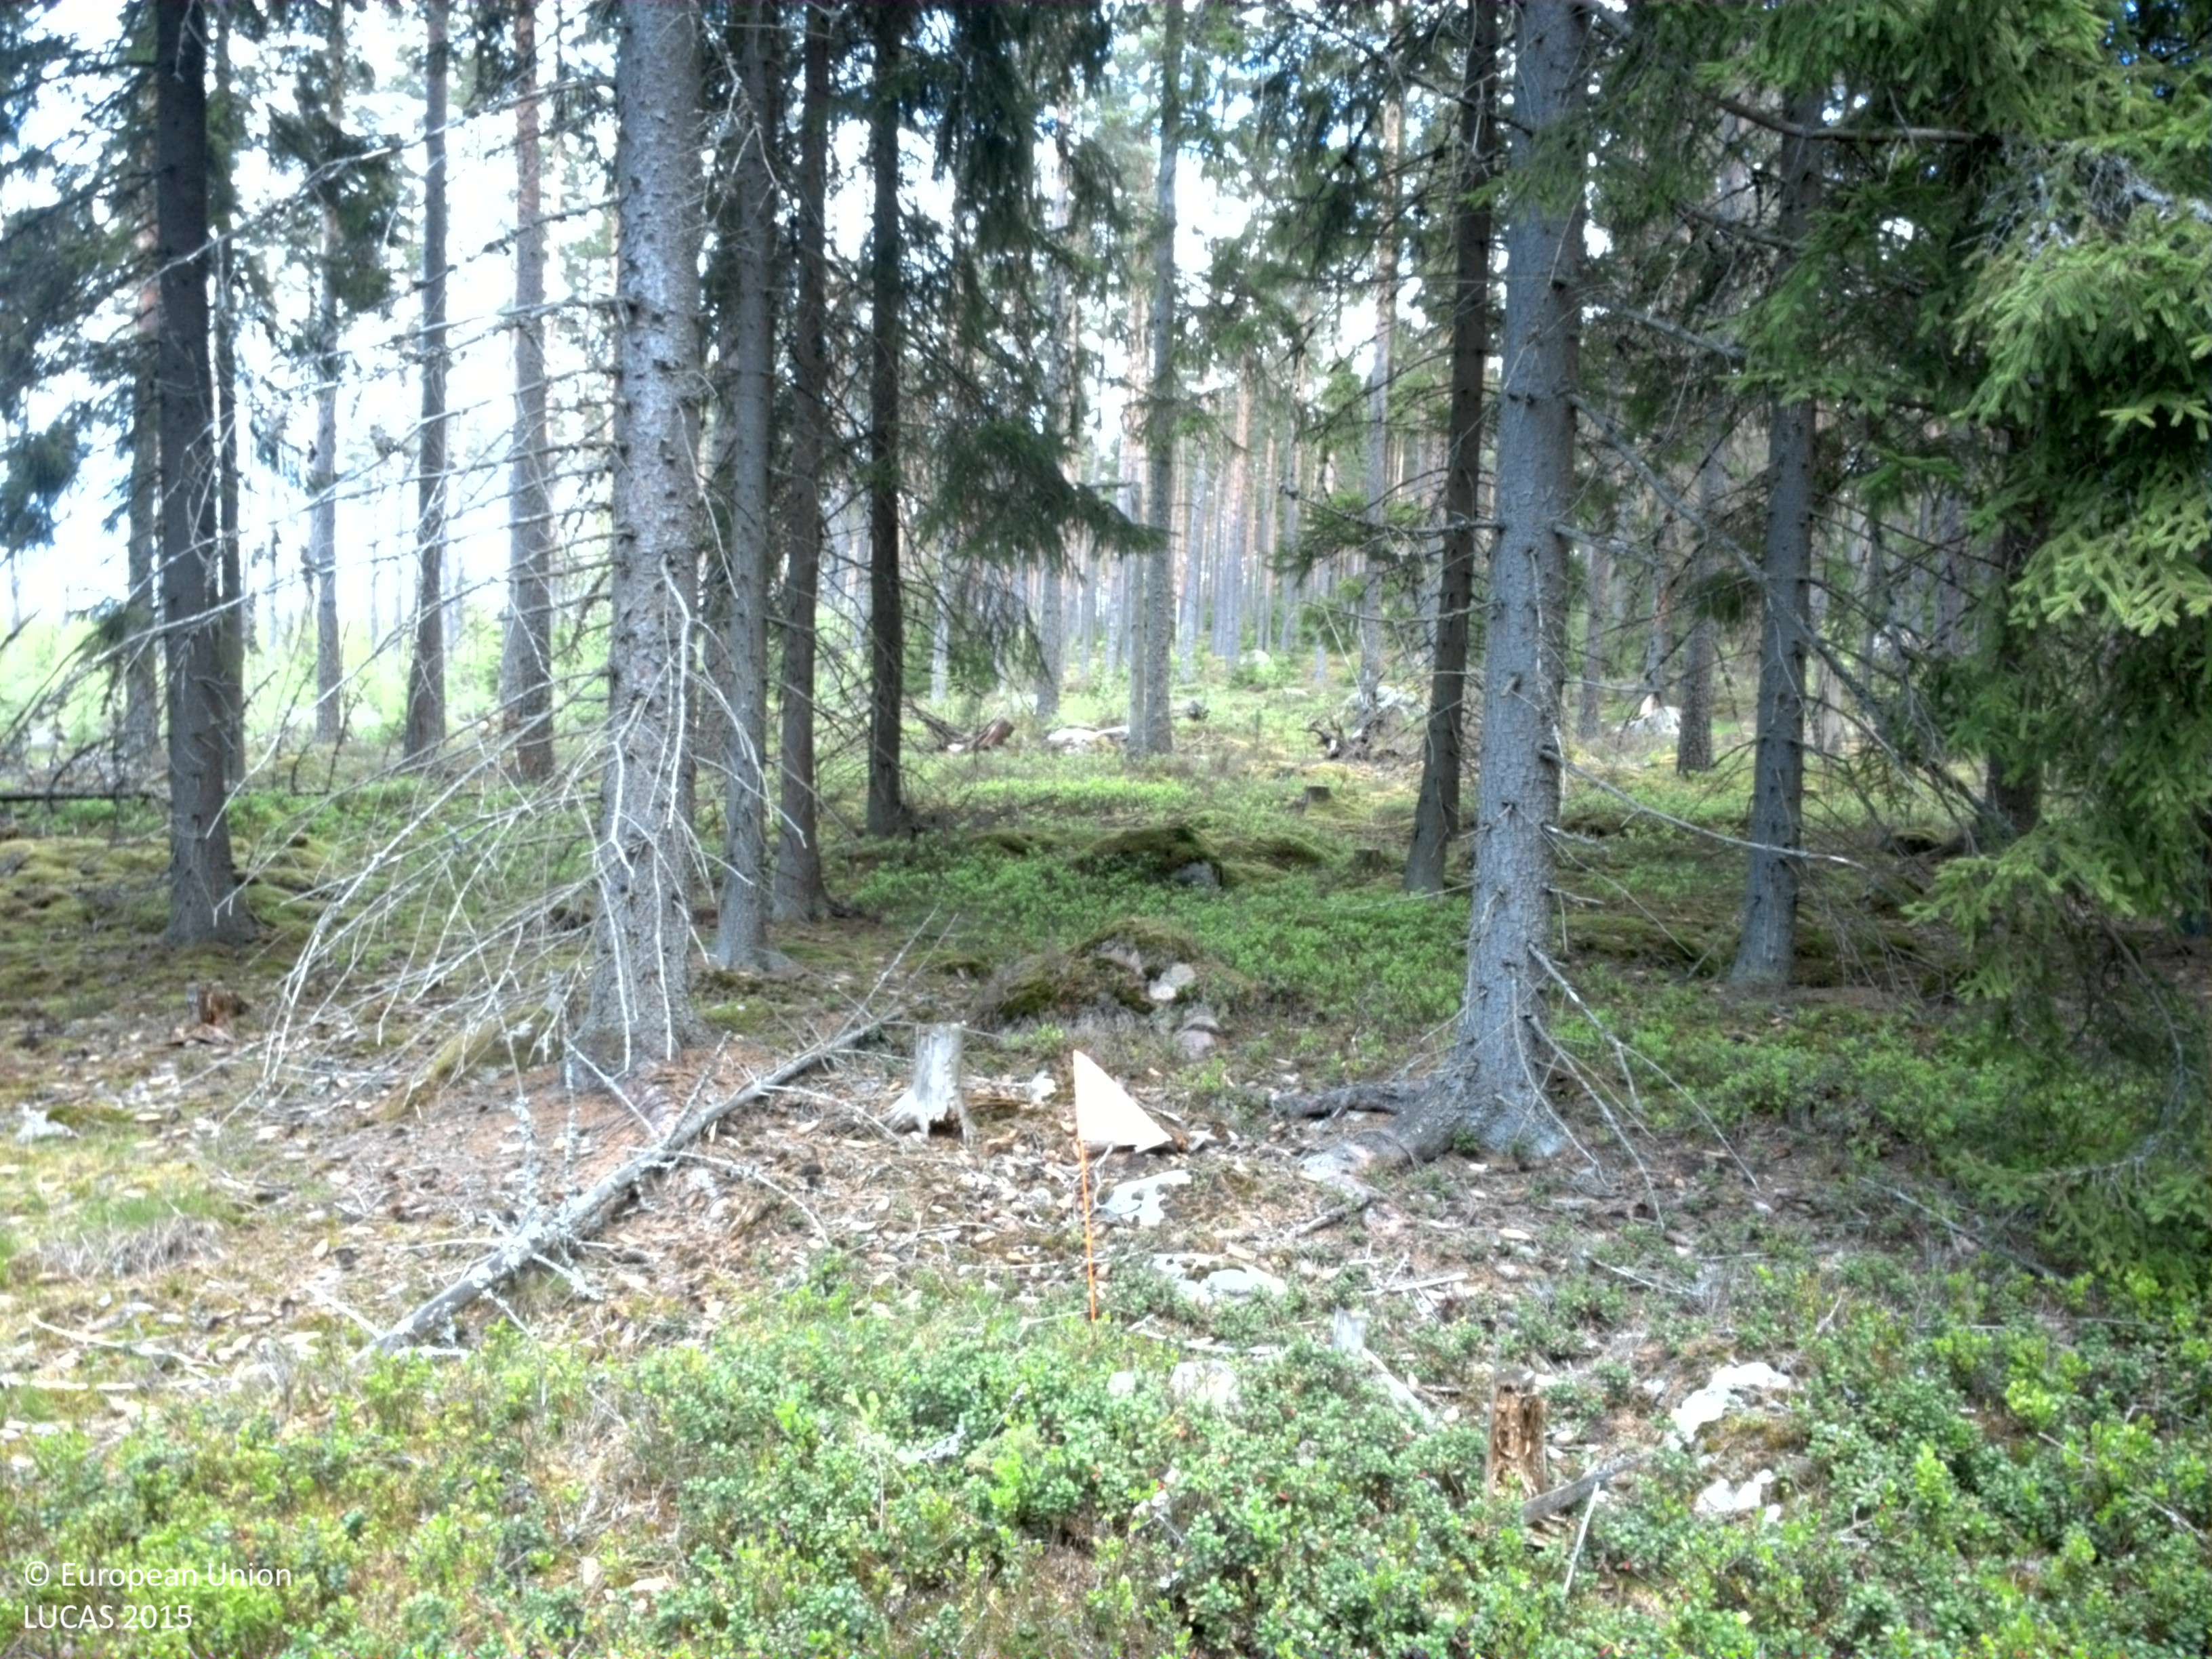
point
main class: Woodland
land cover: Spruce dominated coniferous woodland
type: boreal forest
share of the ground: 50 - 75 %
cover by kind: coniferous forest trees 60 %, shrubs 15 %, lichens and mosses 15 %, broadleaved forest trees 10 %
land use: Forestry
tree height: > 5 m
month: May
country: SE
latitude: 56.7818
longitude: 15.2845
